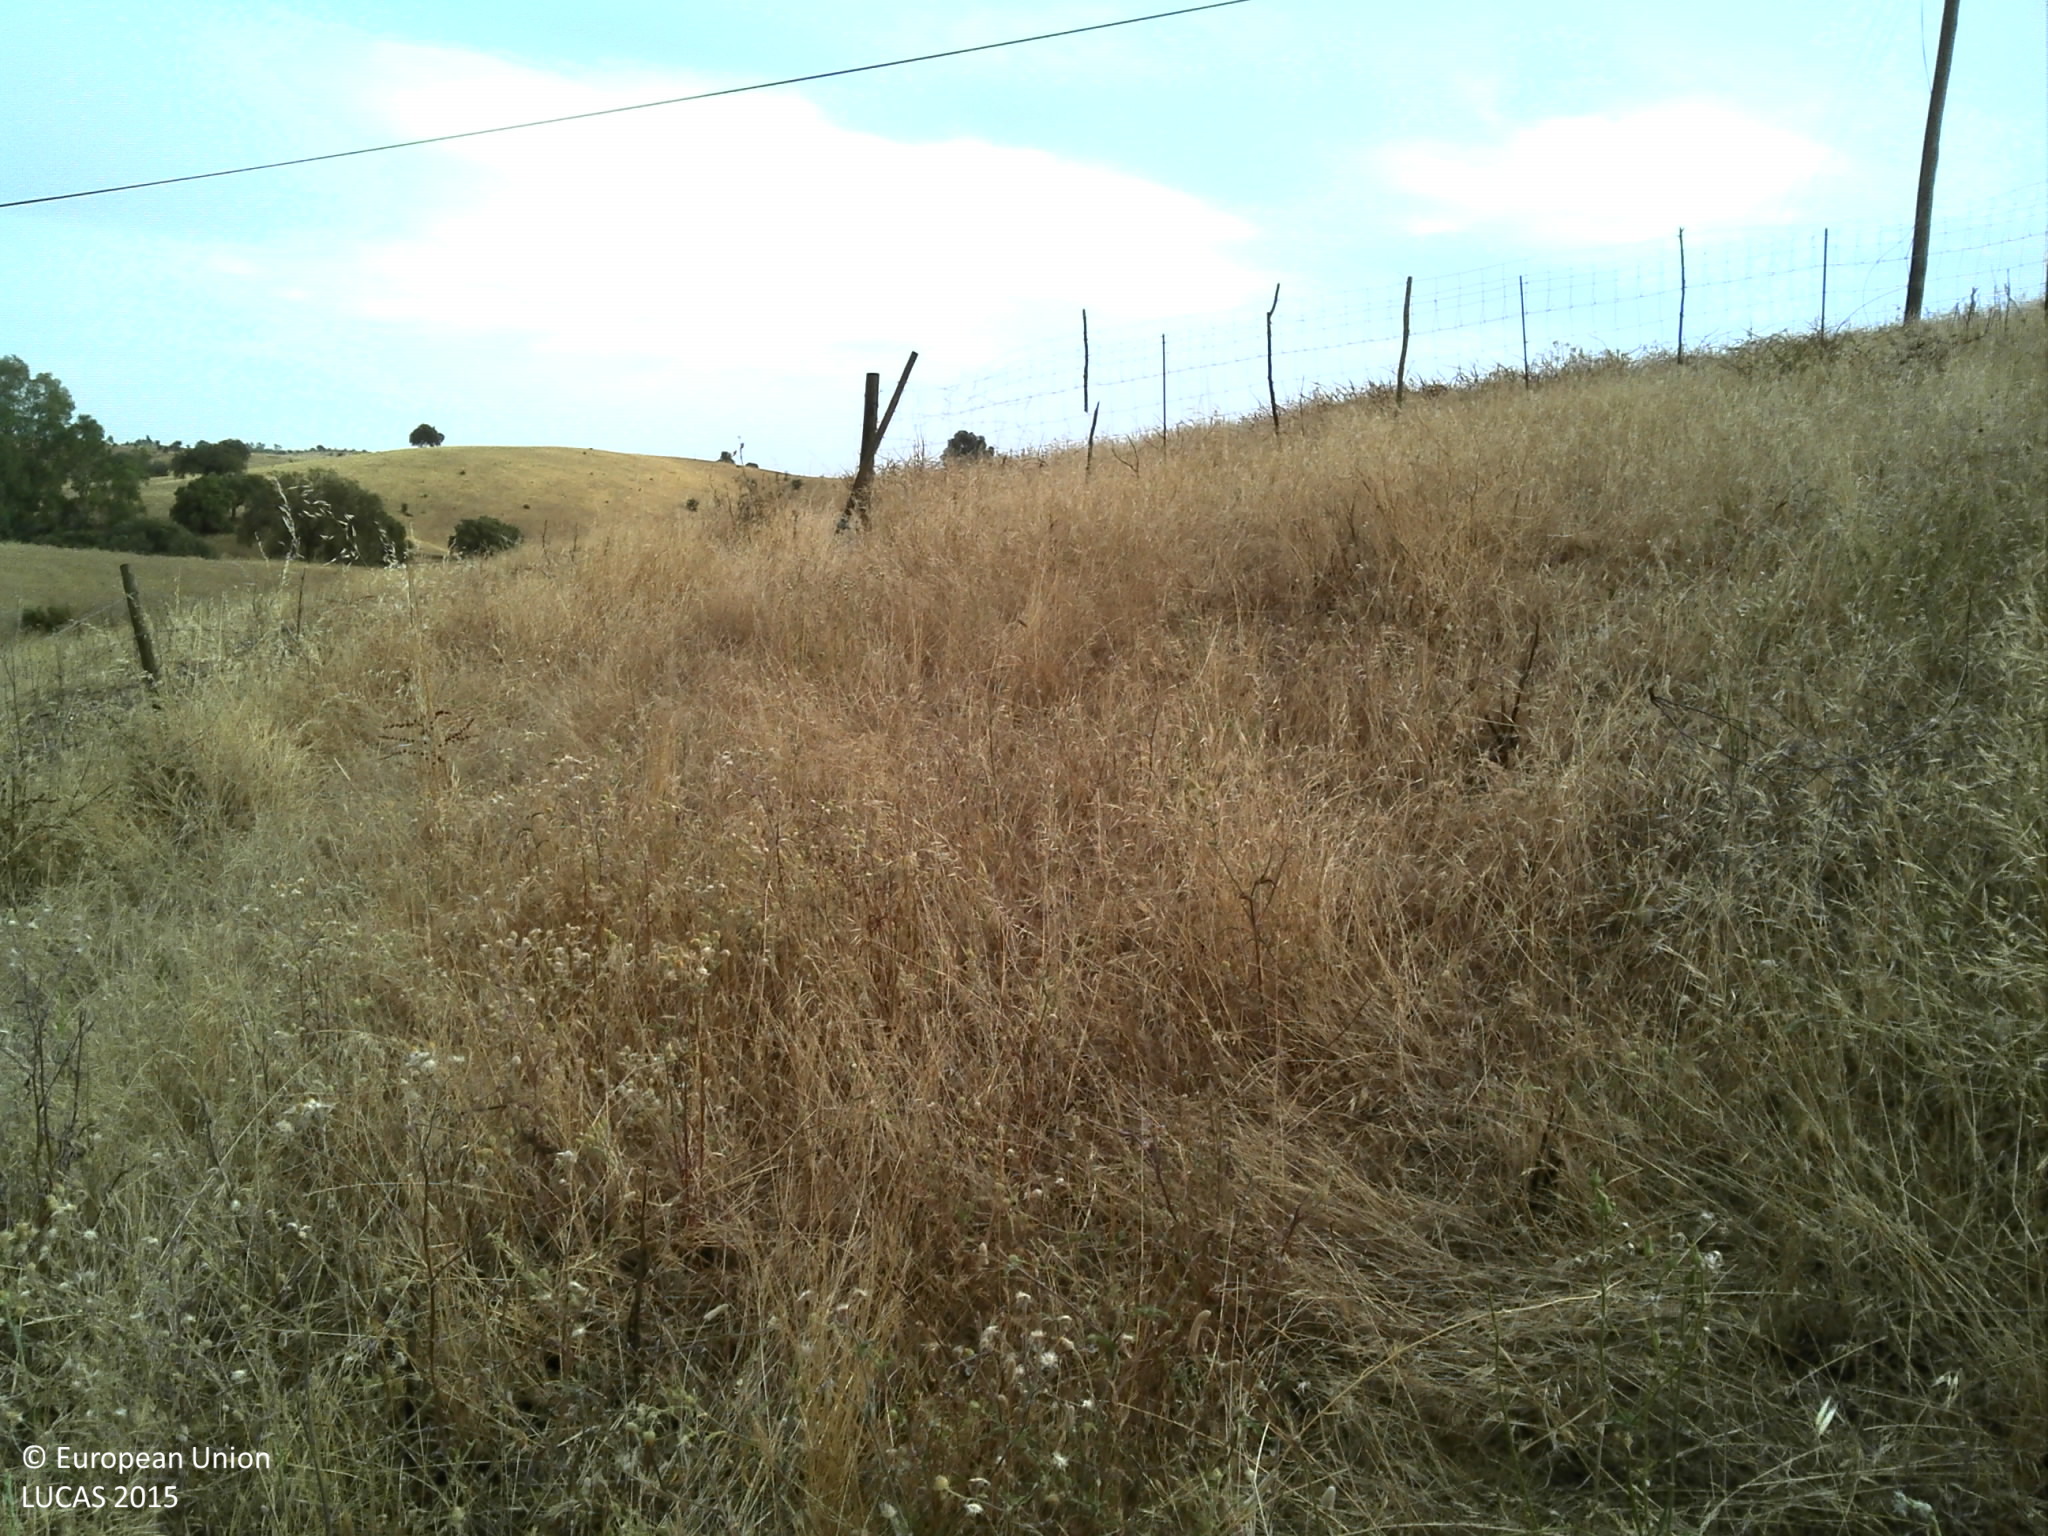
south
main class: Grassland
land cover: Grassland without tree/shrub cover
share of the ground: > 75 %
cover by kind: herbaceous plants 100 %
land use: Agriculture (excluding fallow land and kitchen gardens)
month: June
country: PT
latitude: 37.7476
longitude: -7.5497
